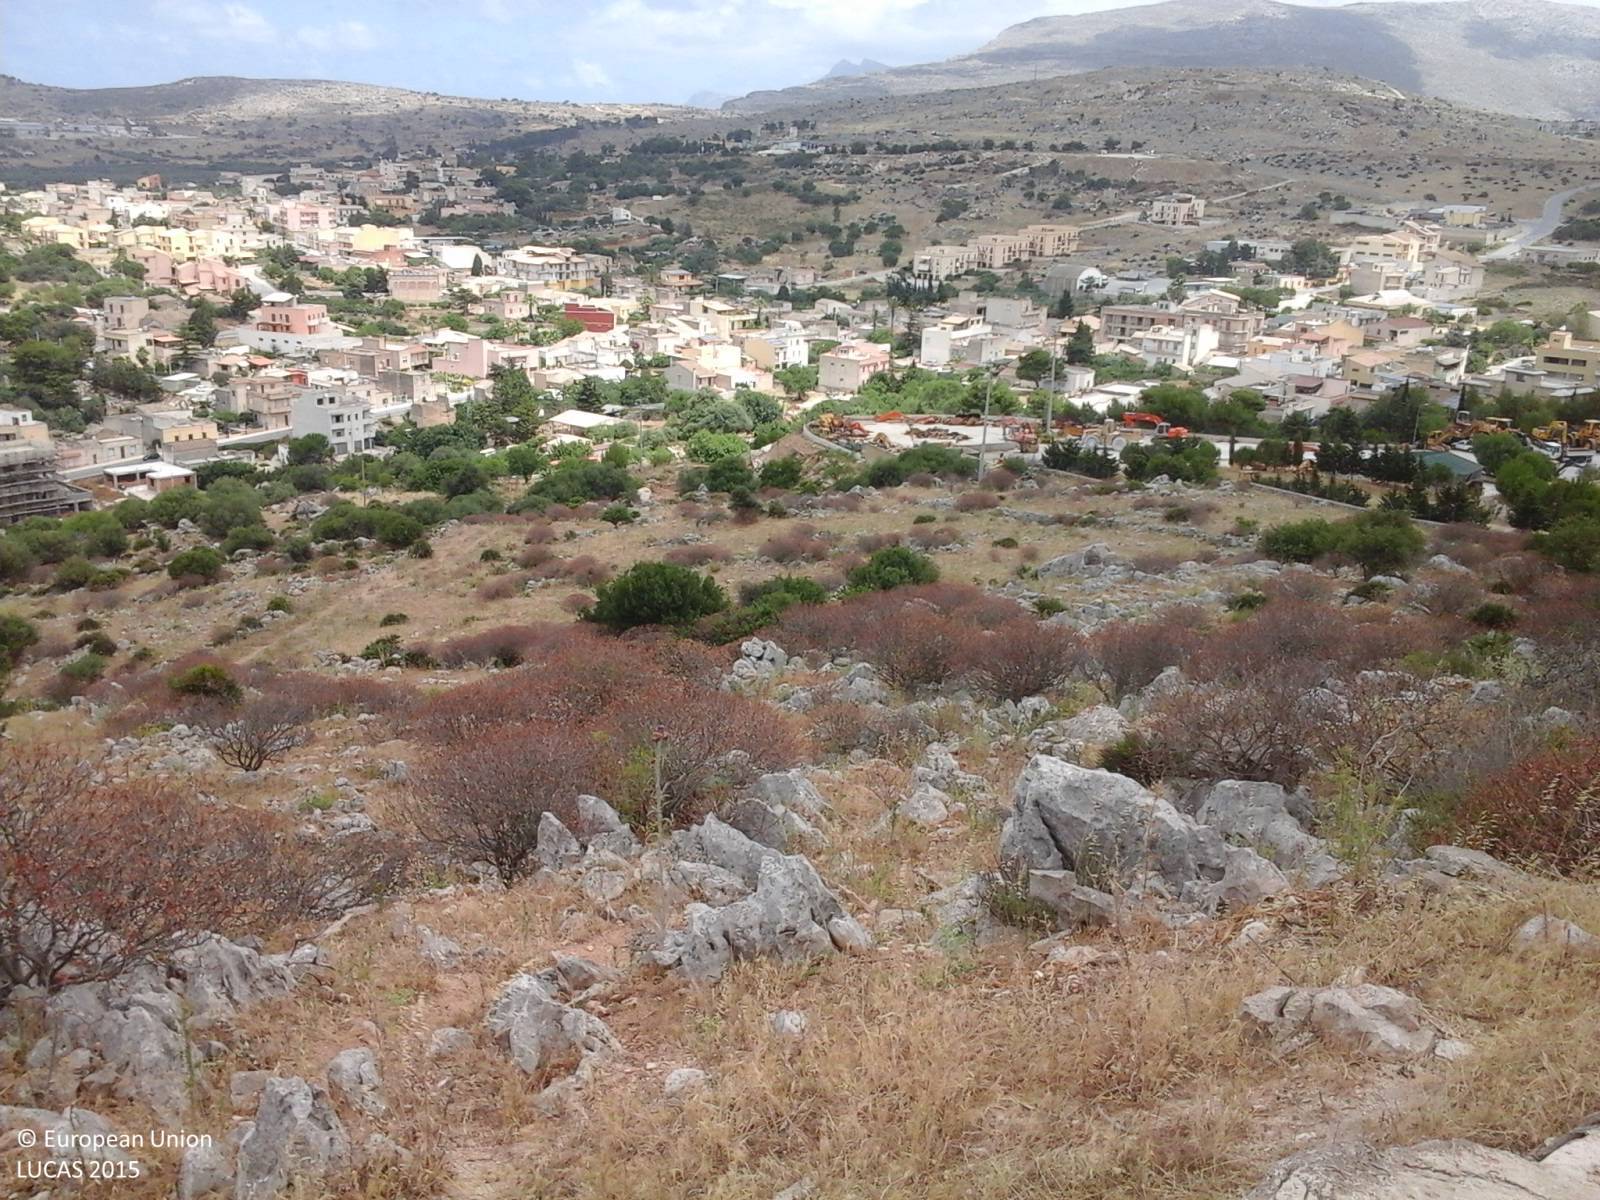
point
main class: Grassland
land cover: Grassland with sparse tree/shrub cover
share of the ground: > 75 %
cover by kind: herbaceous plants 55 %, consolidated bare surface 30 %, shrubs 10 %, coniferous forest trees 5 %
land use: Semi-natural and natural areas not in use
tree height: < 5 m
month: June
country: IT
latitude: 38.0729
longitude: 12.6824
